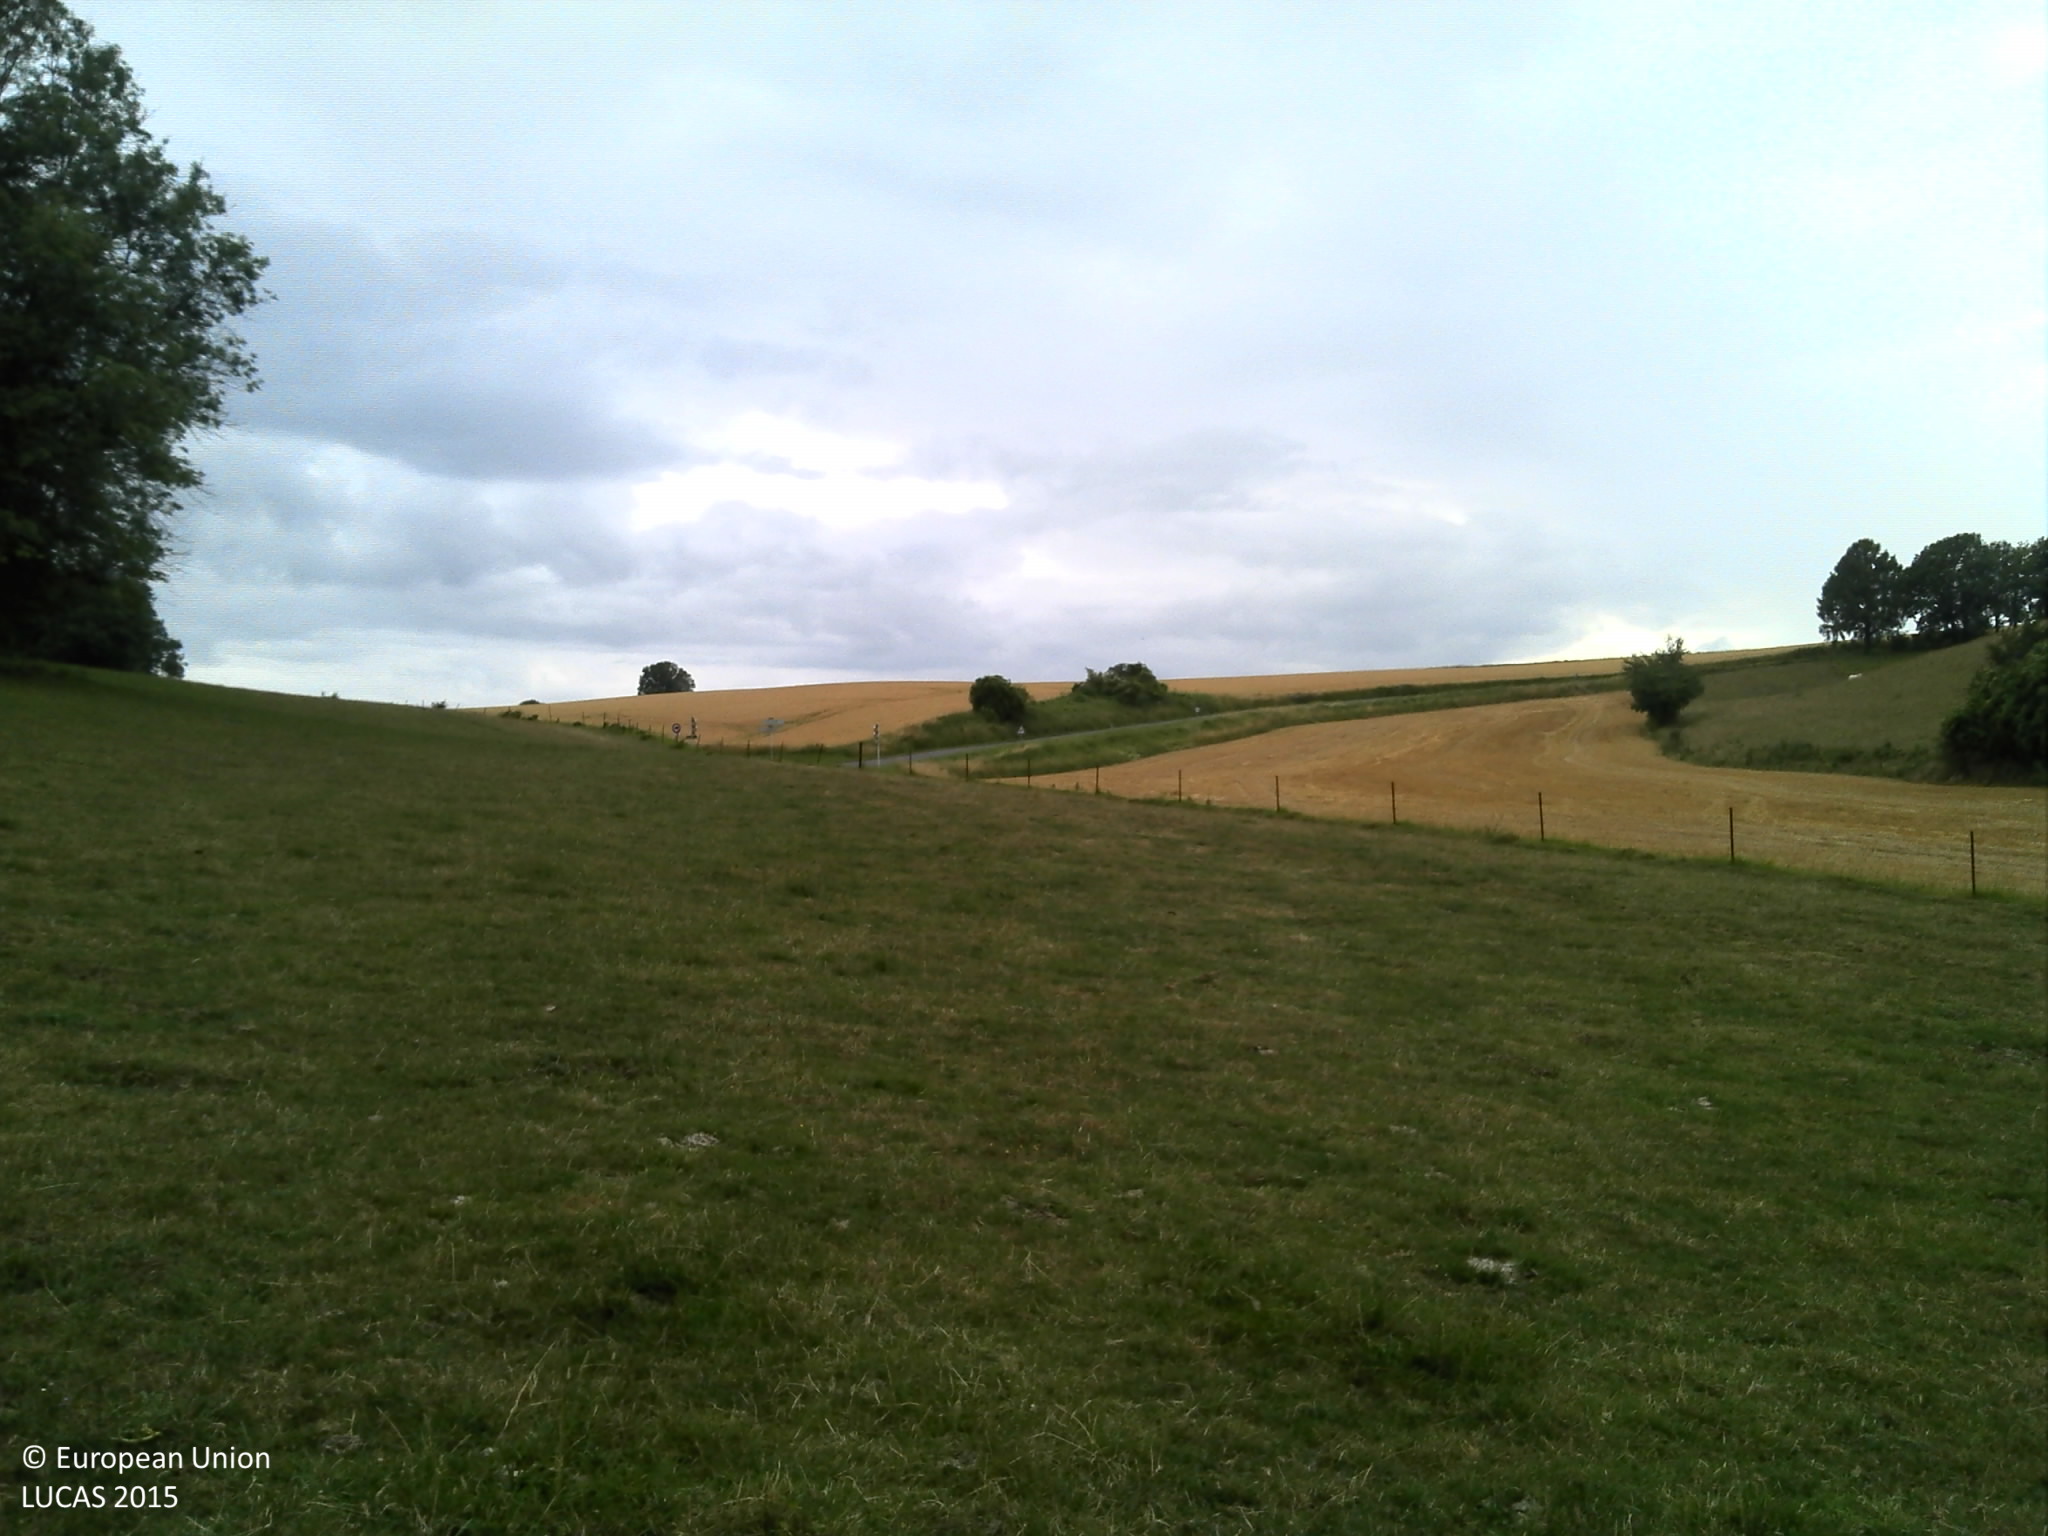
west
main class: Grassland
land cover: Grassland without tree/shrub cover
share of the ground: > 75 %
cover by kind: herbaceous plants 100 %
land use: Agriculture (excluding fallow land and kitchen gardens)
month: July
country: FR
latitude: 49.7332
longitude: 4.6271
